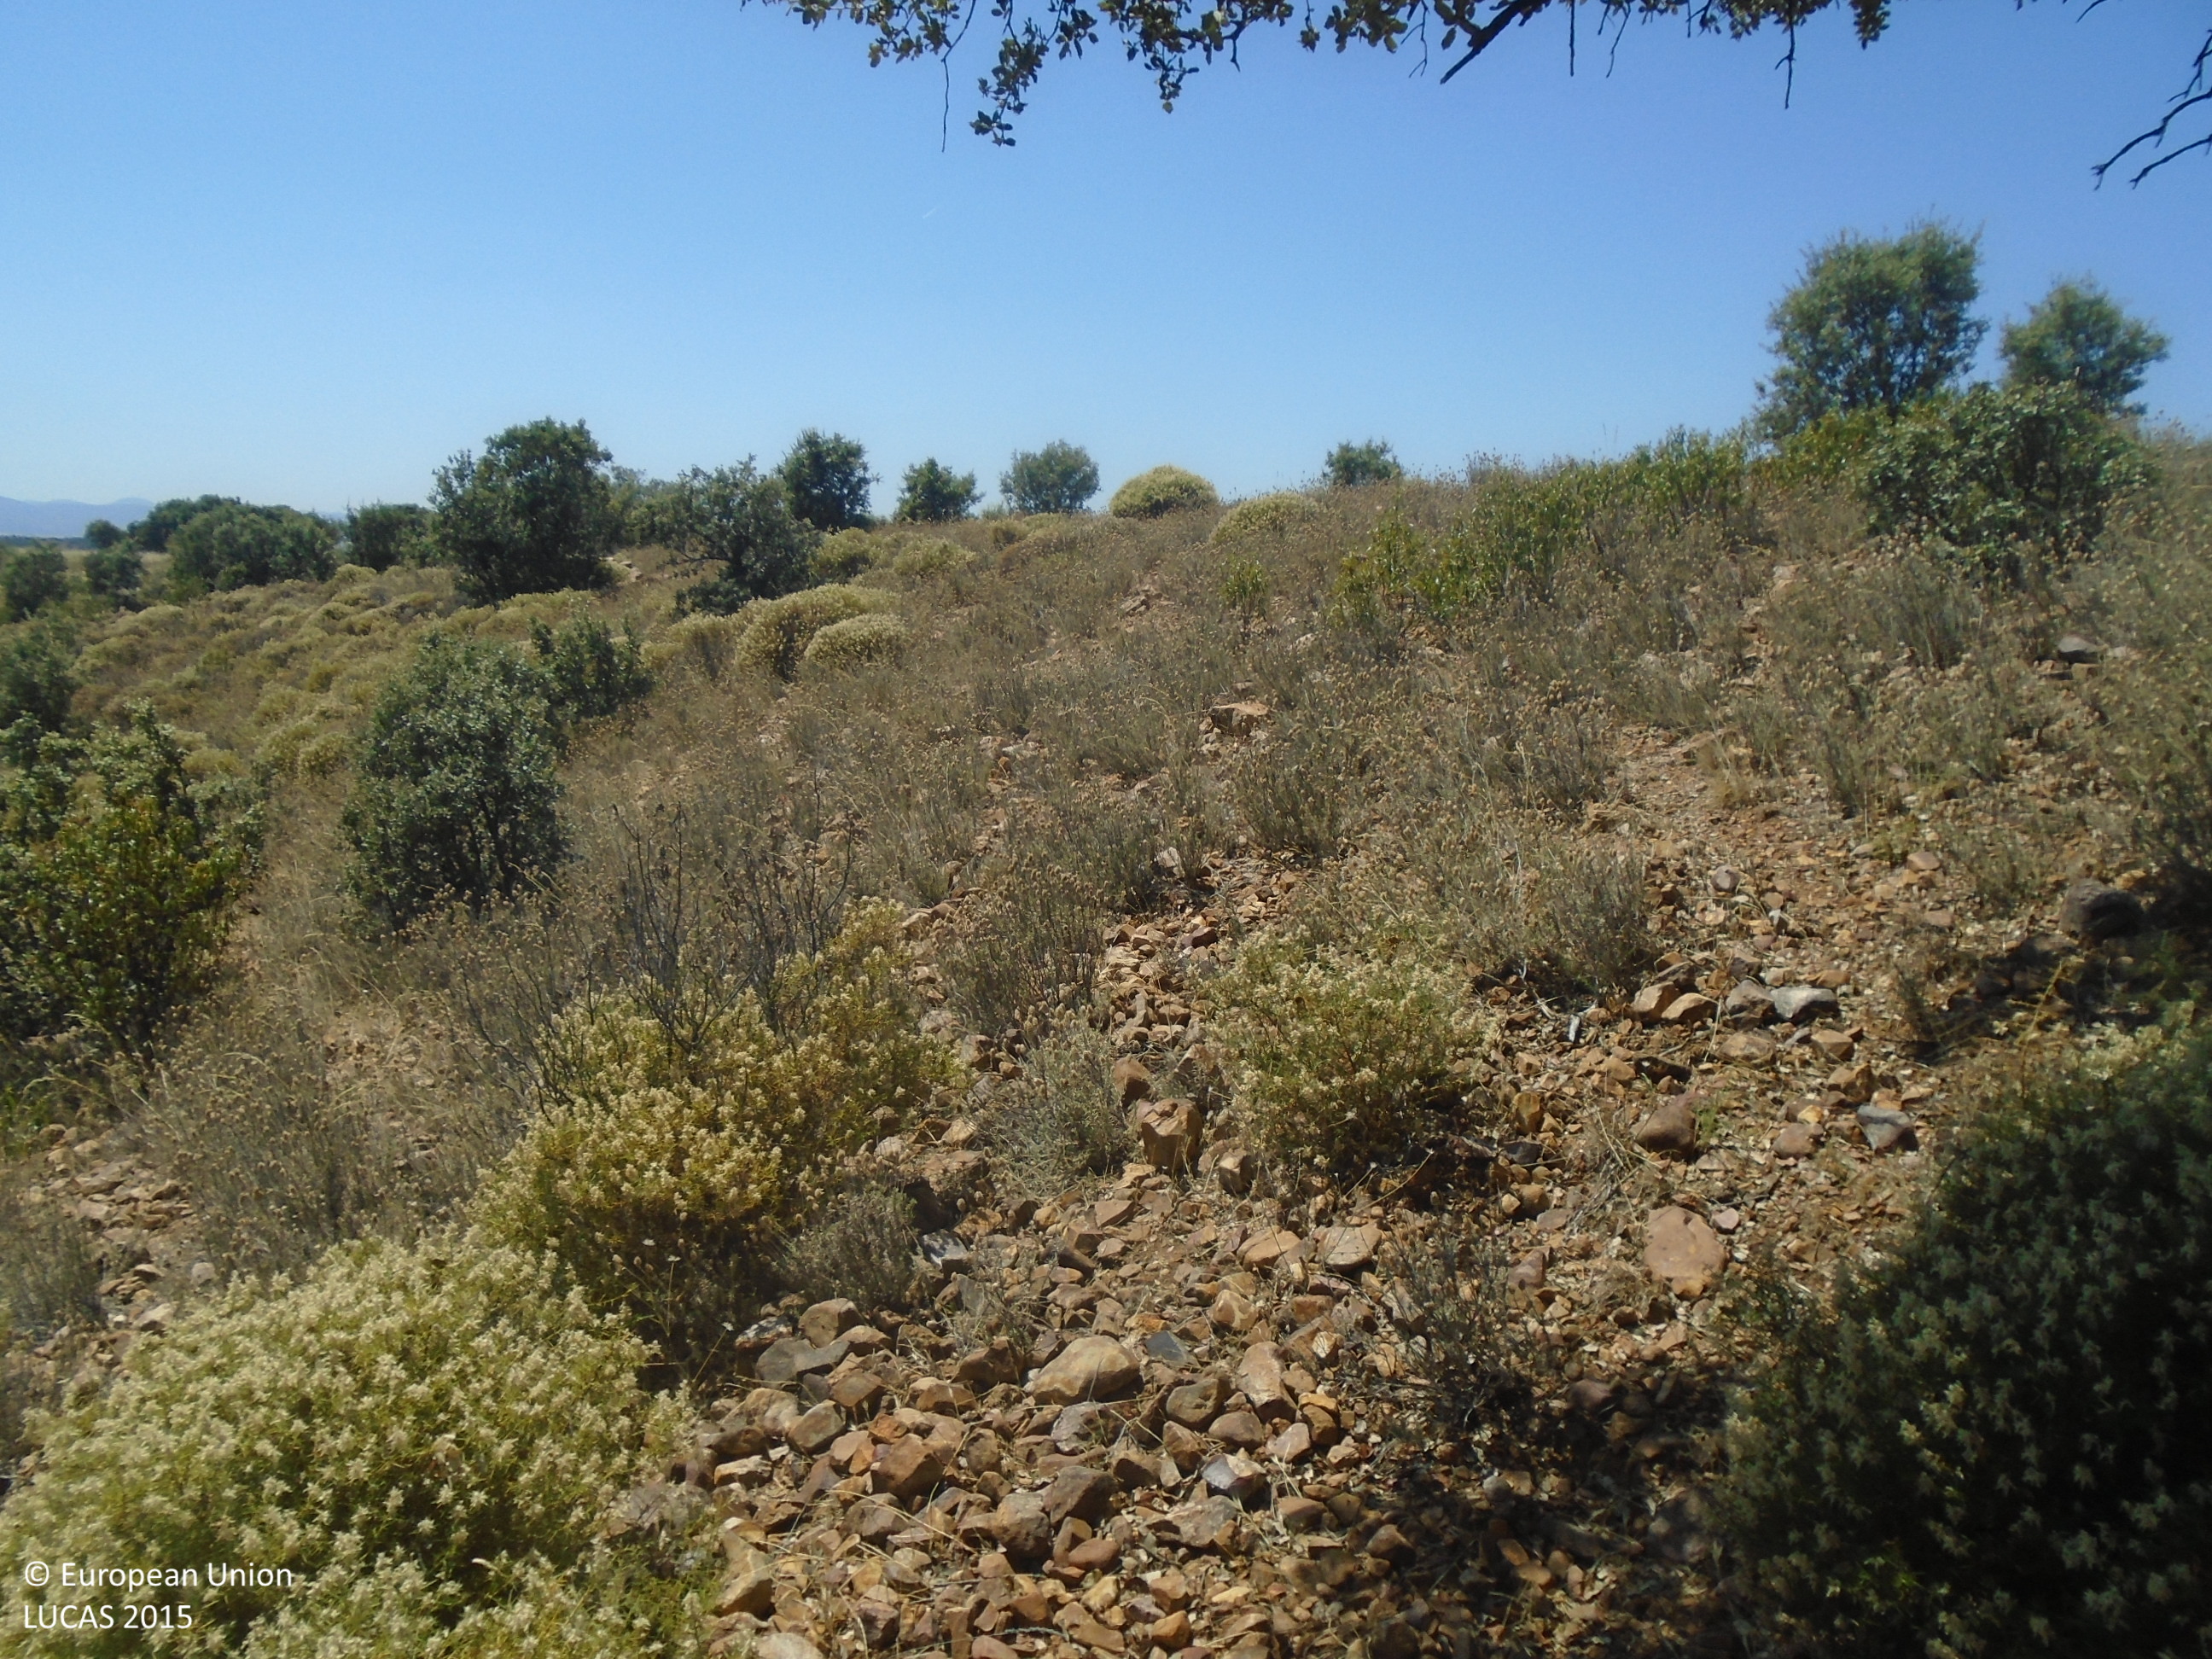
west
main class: Shrubland
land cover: Shrubland with sparse tree cover
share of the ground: > 75 %
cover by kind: shrubs 95 %, broadleaved forest trees 5 %
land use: Semi-natural and natural areas not in use
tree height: > 5 m
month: July
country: ES
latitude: 39.6968
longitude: -4.9852
